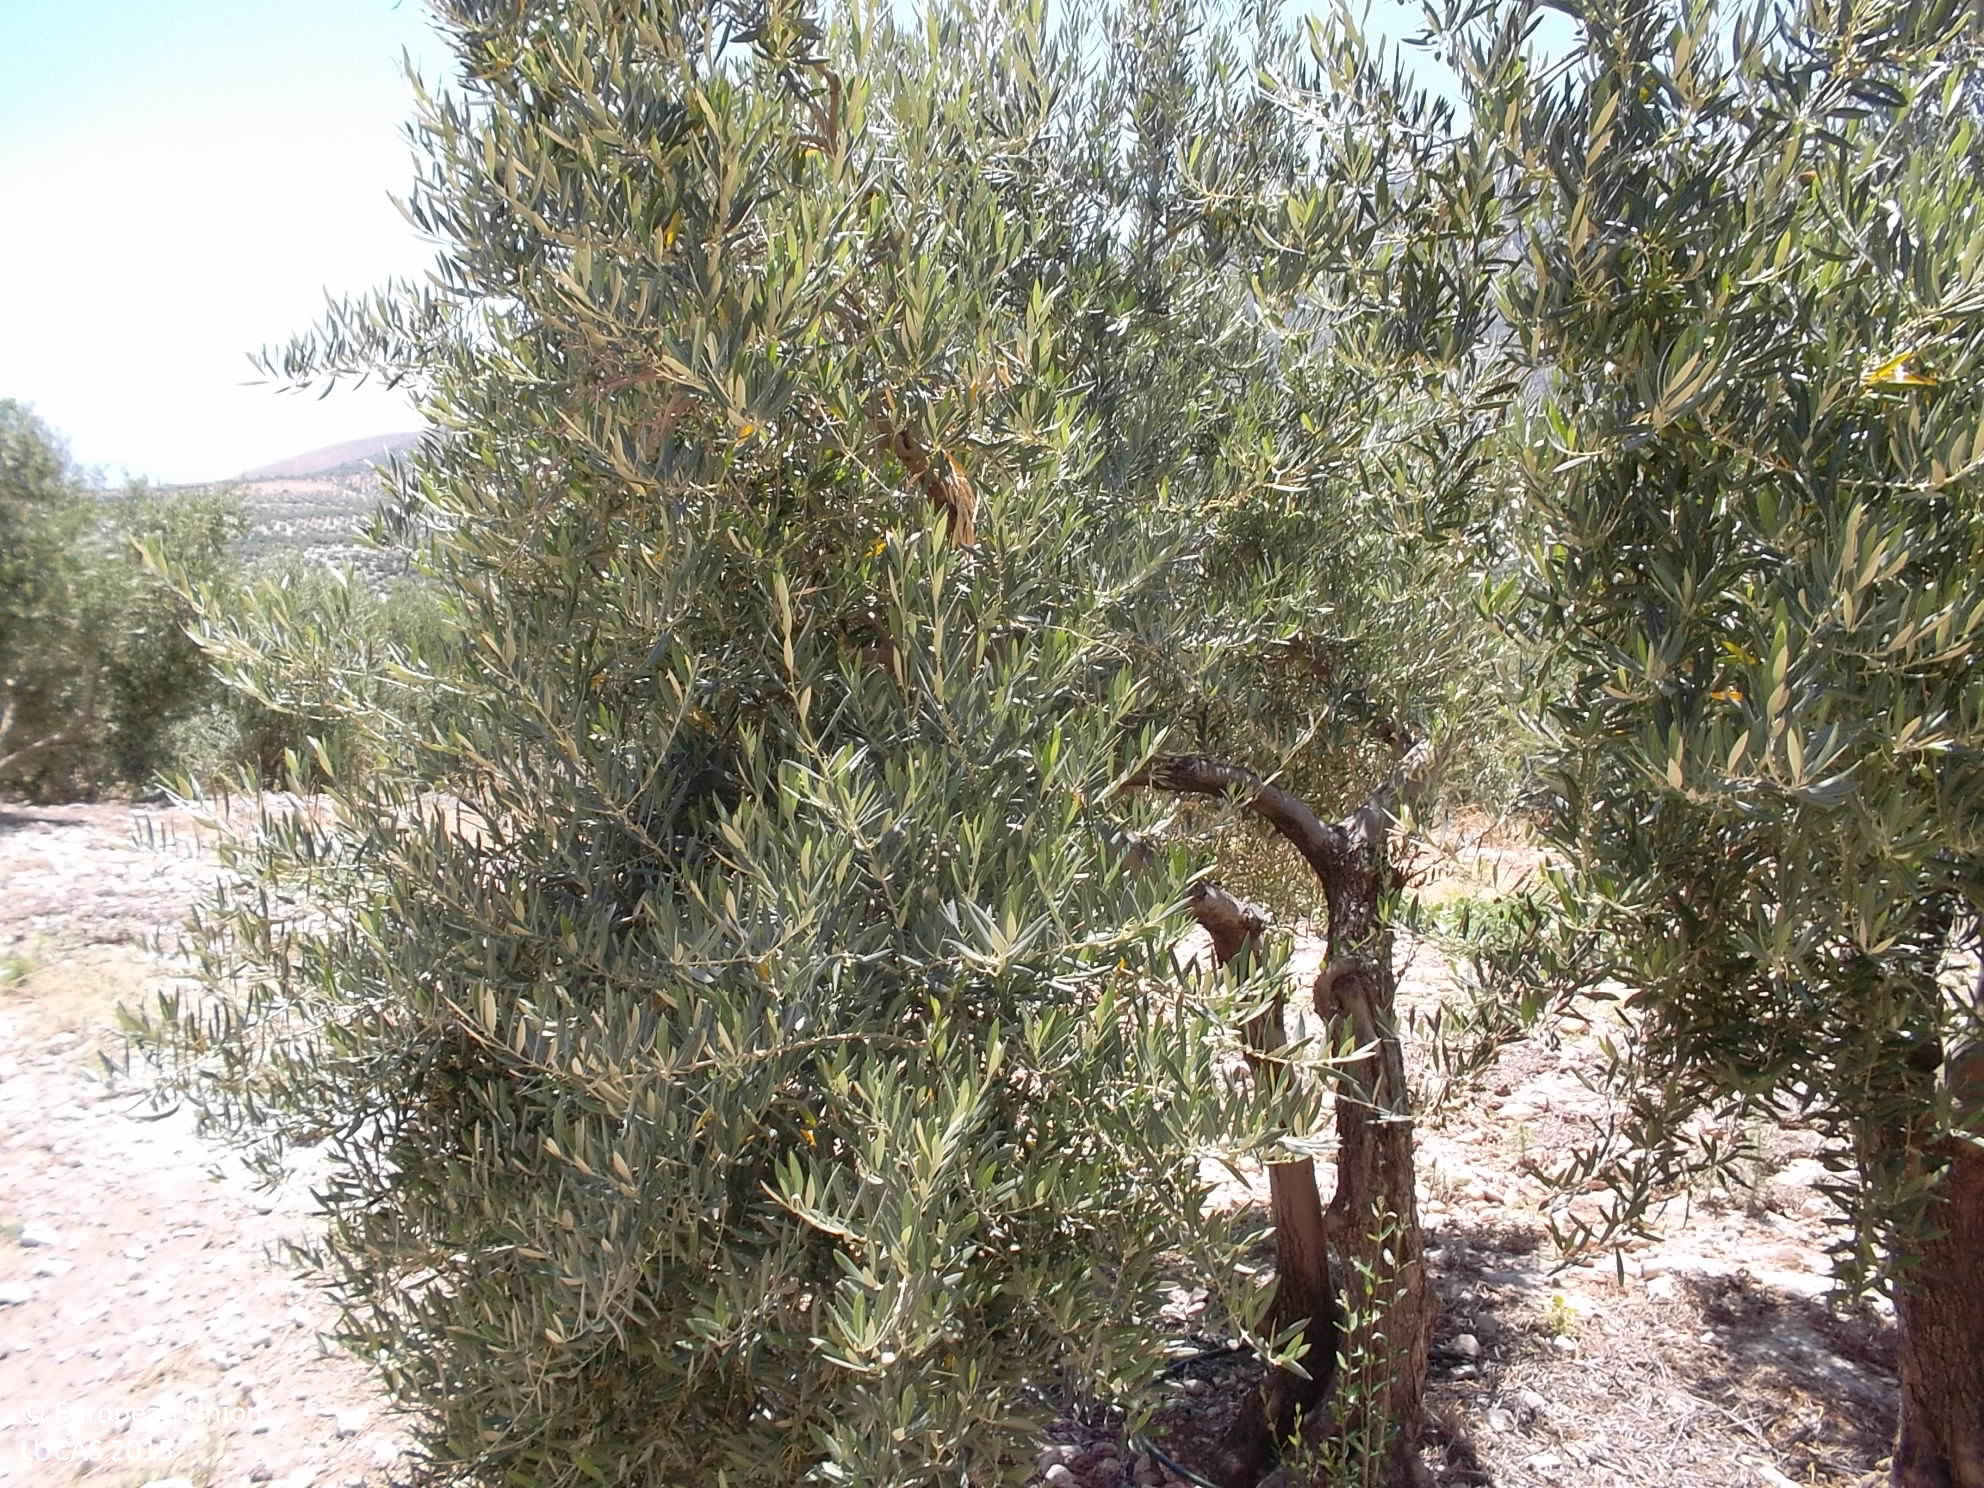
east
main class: Cropland
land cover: Olive groves
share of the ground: 25 - 50 %
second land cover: Grassland without tree/shrub cover
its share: 10 - 25 %
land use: Agriculture (excluding fallow land and kitchen gardens)
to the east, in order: Olive groves; Grassland without tree/shrub cover; Grassland with sparse tree/shrub cover; Grass margins; Olive groves; Grass margins; Olive groves
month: June
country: ES
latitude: 37.8265
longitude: -3.3694
